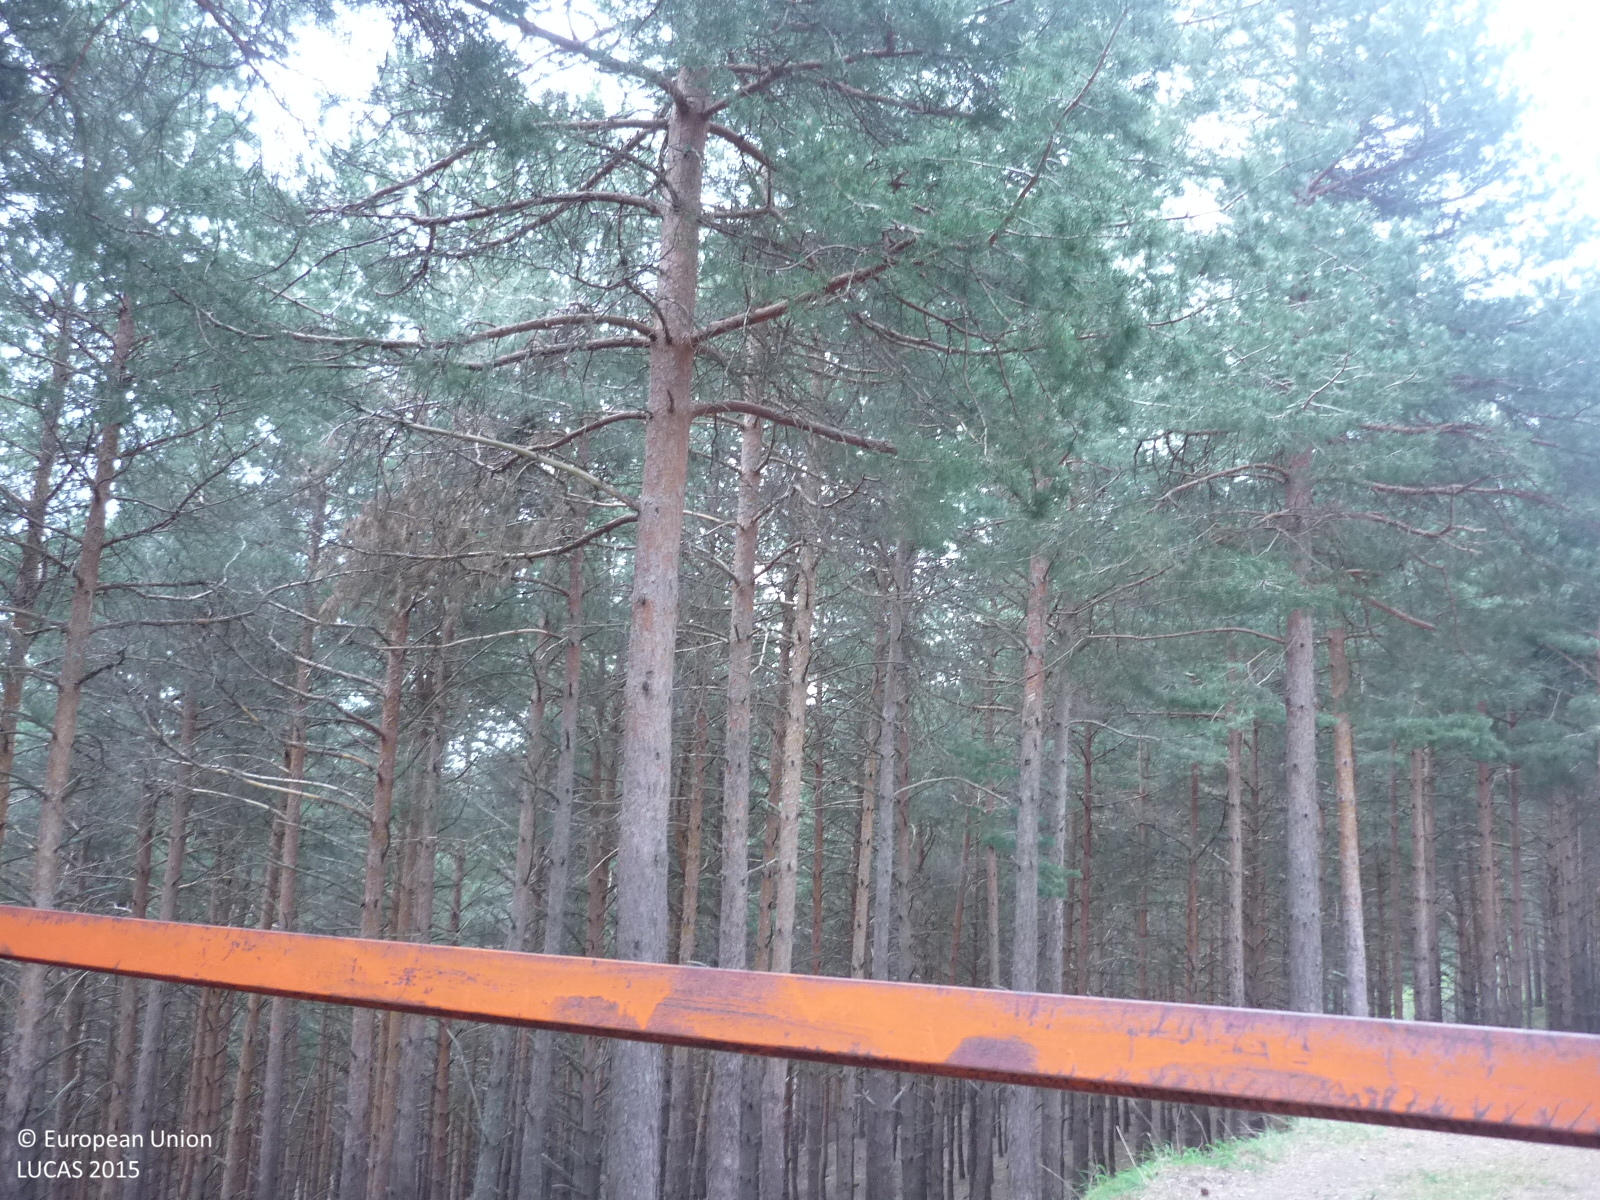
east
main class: Woodland
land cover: Pine dominated coniferous woodland
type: coniferous forest of the mediterranean region
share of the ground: > 75 %
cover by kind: coniferous forest trees 85 %, shrubs 10 %, herbaceous plants 5 %
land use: Forestry
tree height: > 5 m
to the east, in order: Pine dominated coniferous woodland; Arable land (only in case pi); Tracks
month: May
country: ES
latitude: 41.0571
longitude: -3.4521
